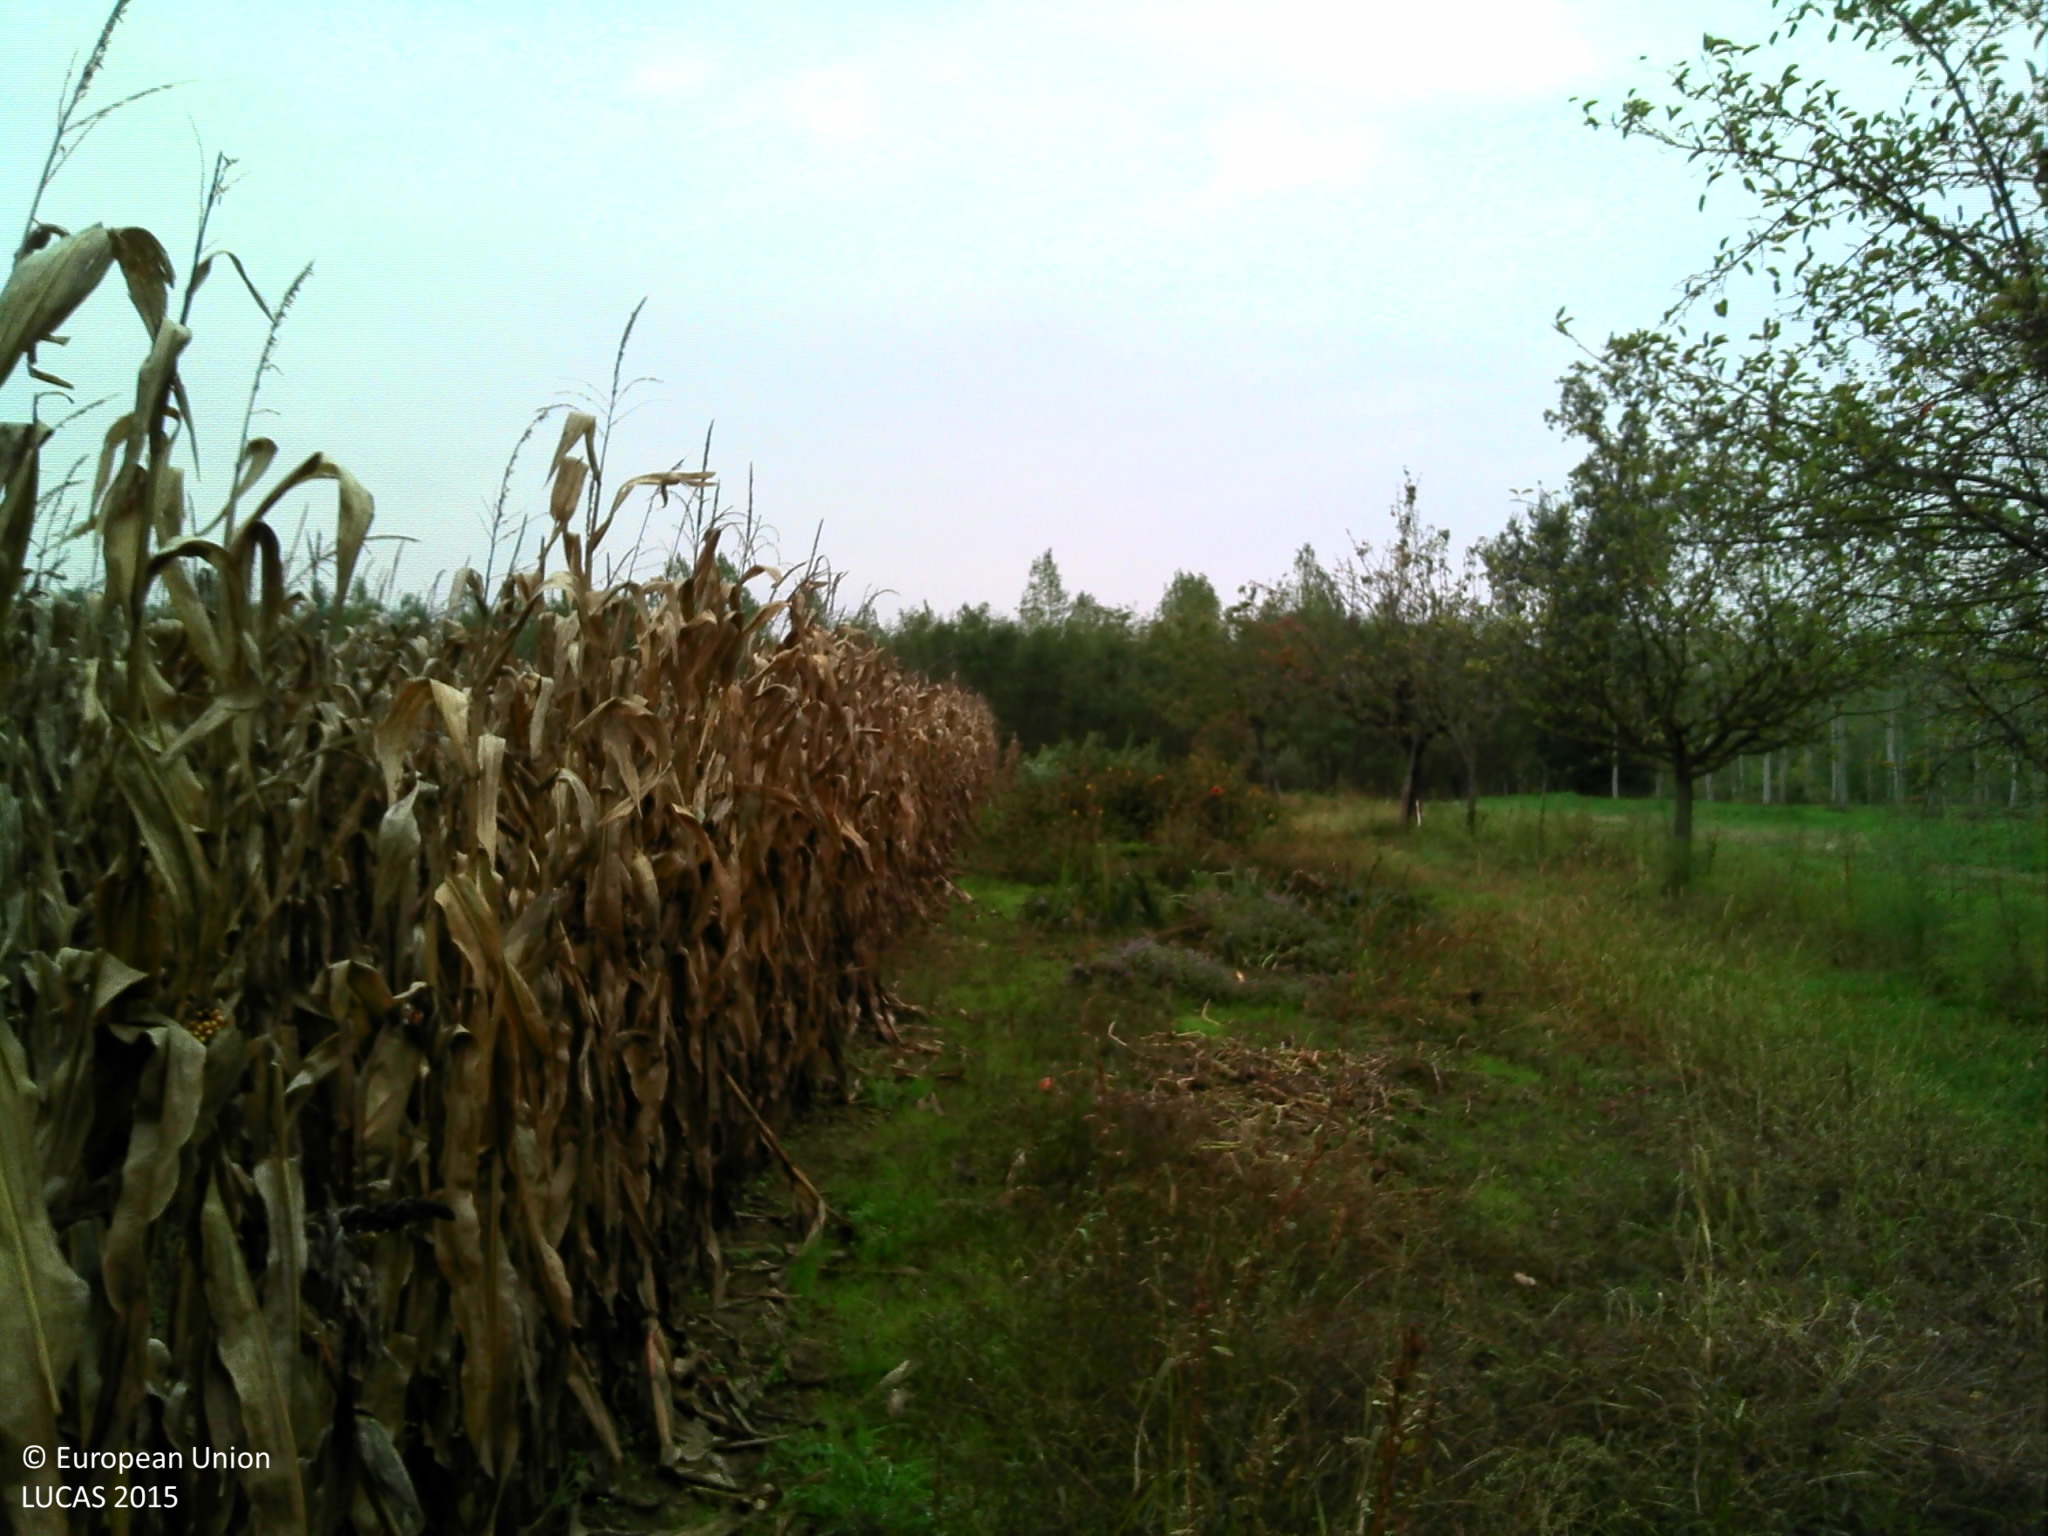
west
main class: Cropland
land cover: Maize
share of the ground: > 75 %
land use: Agriculture (excluding fallow land and kitchen gardens)
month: October
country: FR
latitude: 46.2262
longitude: 4.8293
